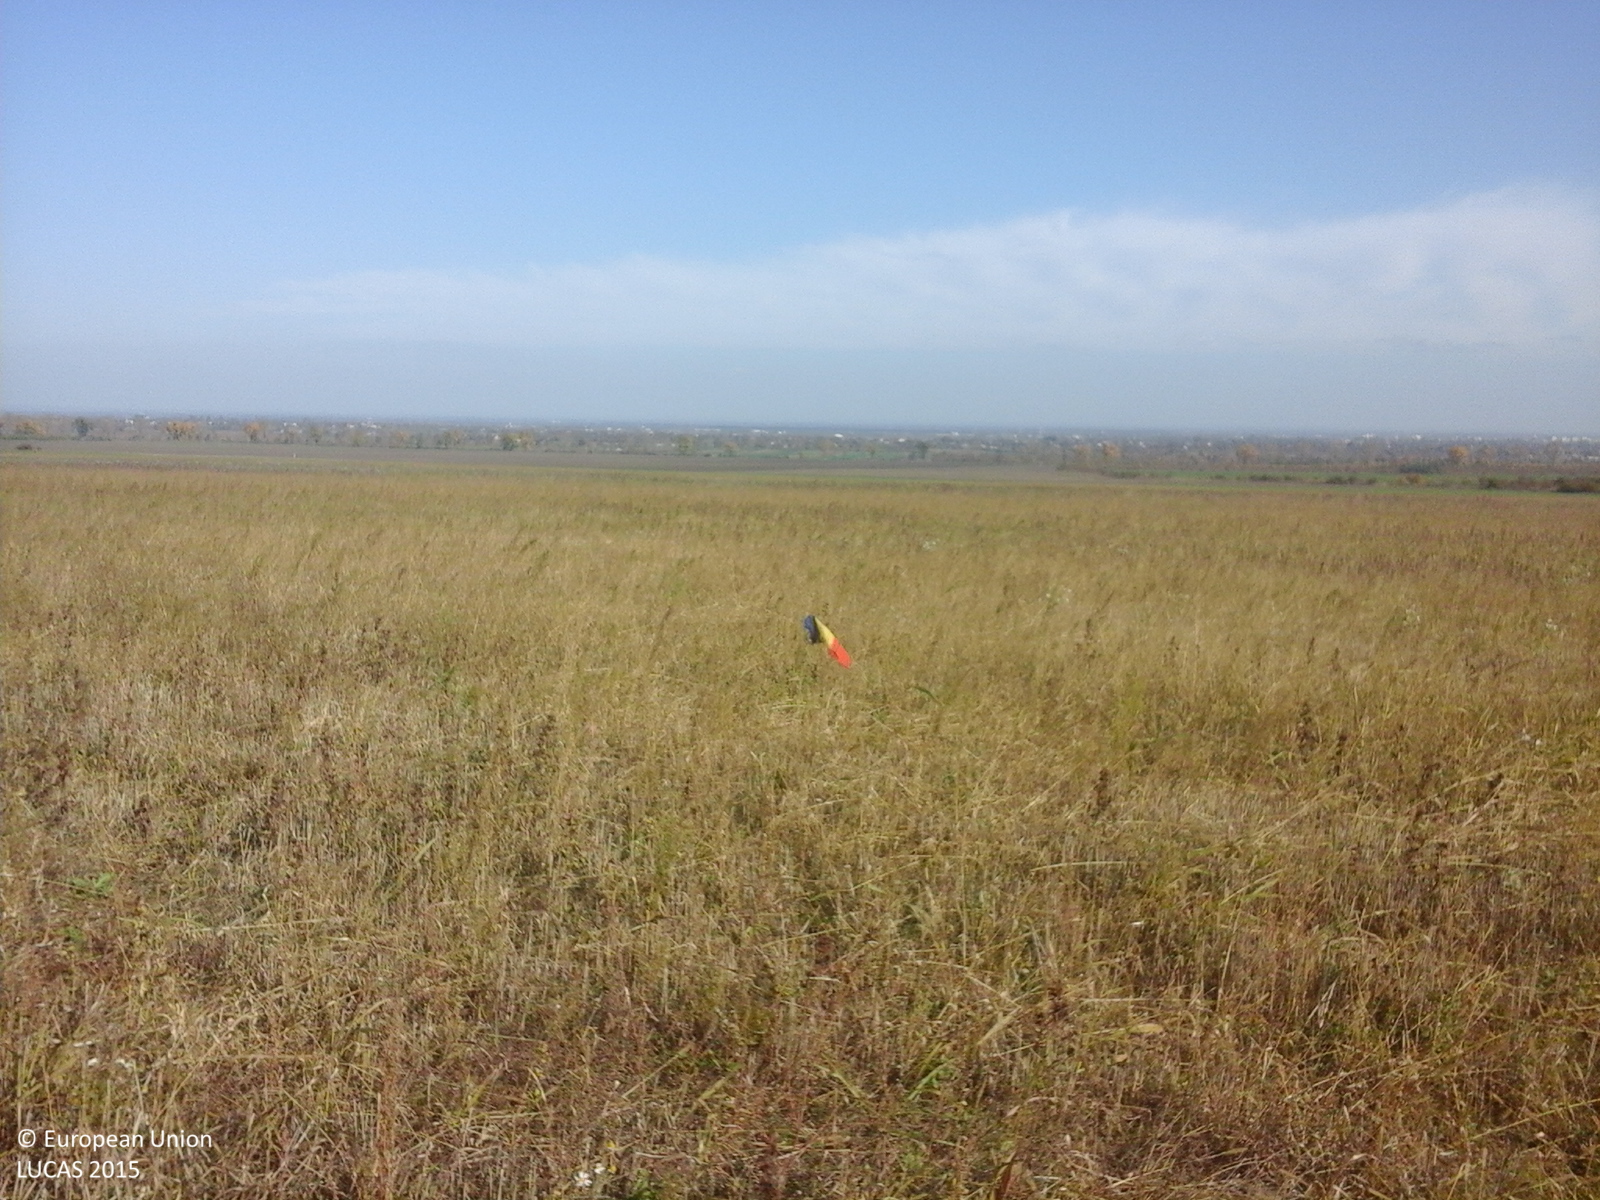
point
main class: Grassland
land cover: Spontaneously vegetated surfaces
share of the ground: > 75 %
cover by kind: herbaceous plants 100 %
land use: Fallow land
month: October
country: RO
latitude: 45.6996
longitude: 27.0834
